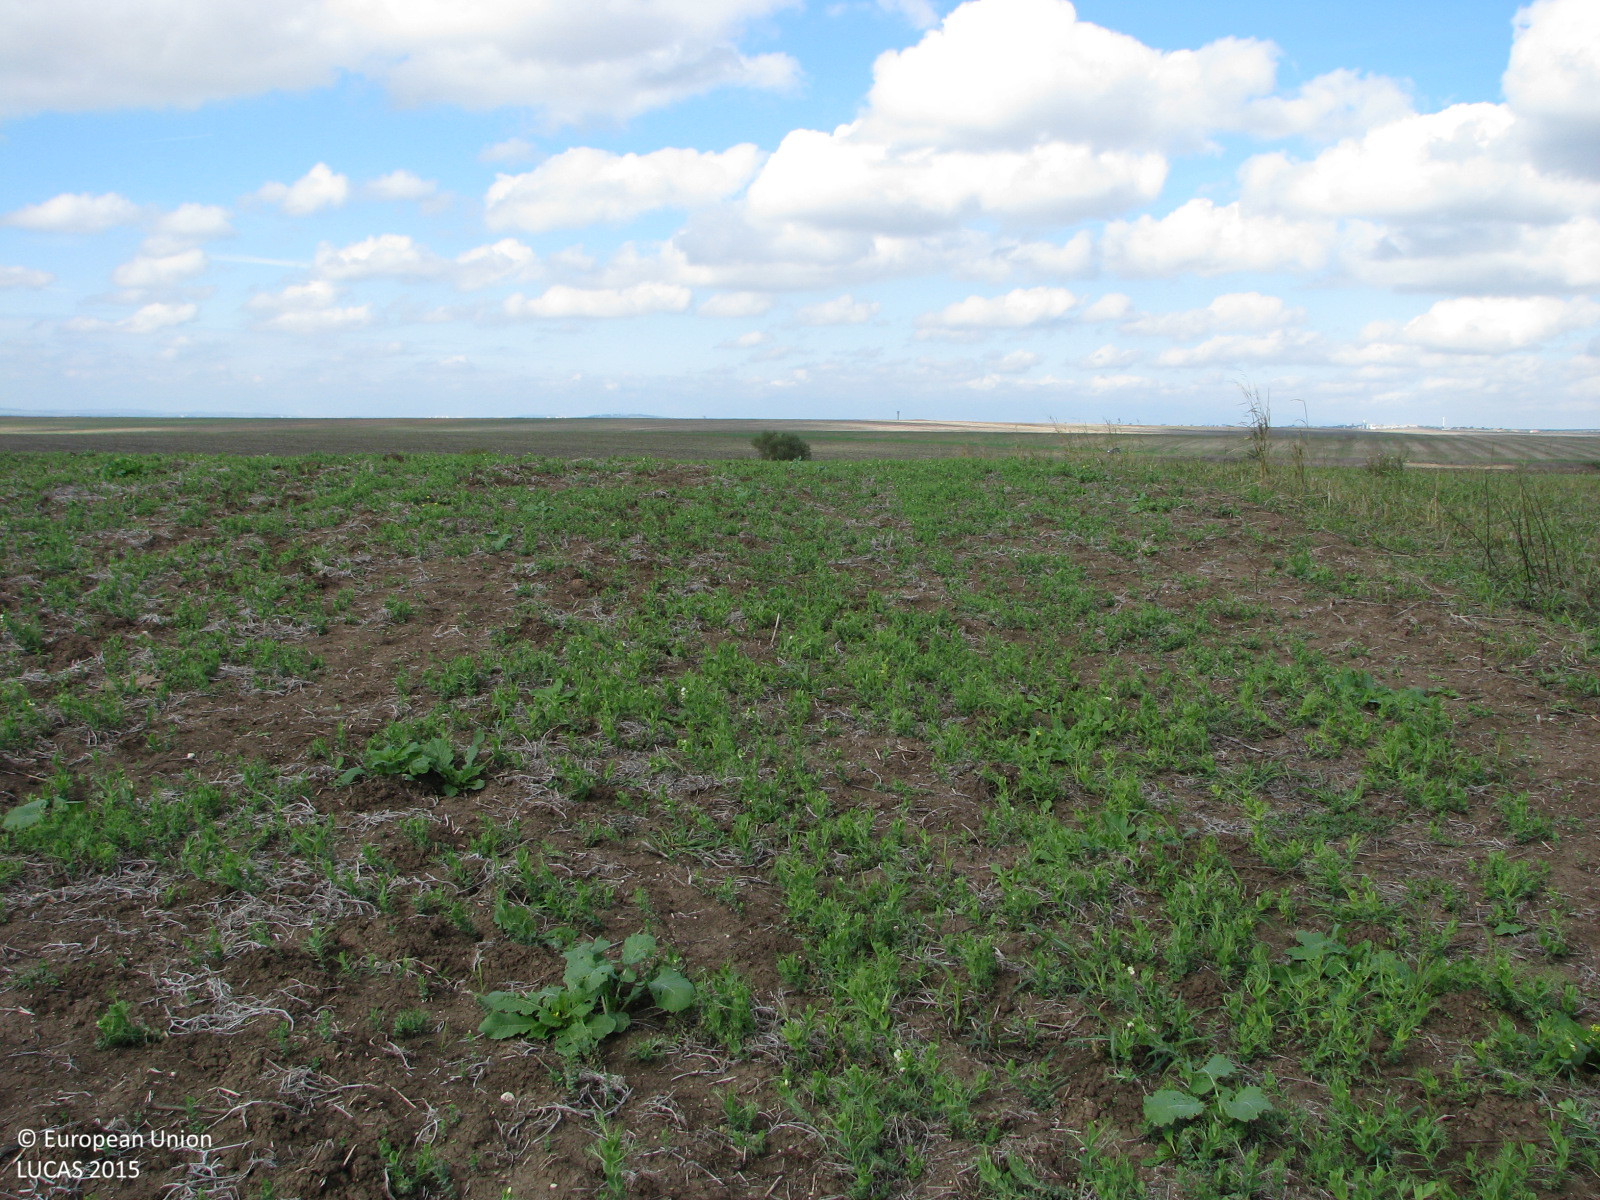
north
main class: Grassland
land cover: Spontaneously vegetated surfaces
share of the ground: 25 - 50 %
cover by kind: unconsolidated bare surface 60 %, herbaceous plants 40 %
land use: Agriculture (excluding fallow land and kitchen gardens)
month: October
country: BG
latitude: 42.3772
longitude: 26.5978
